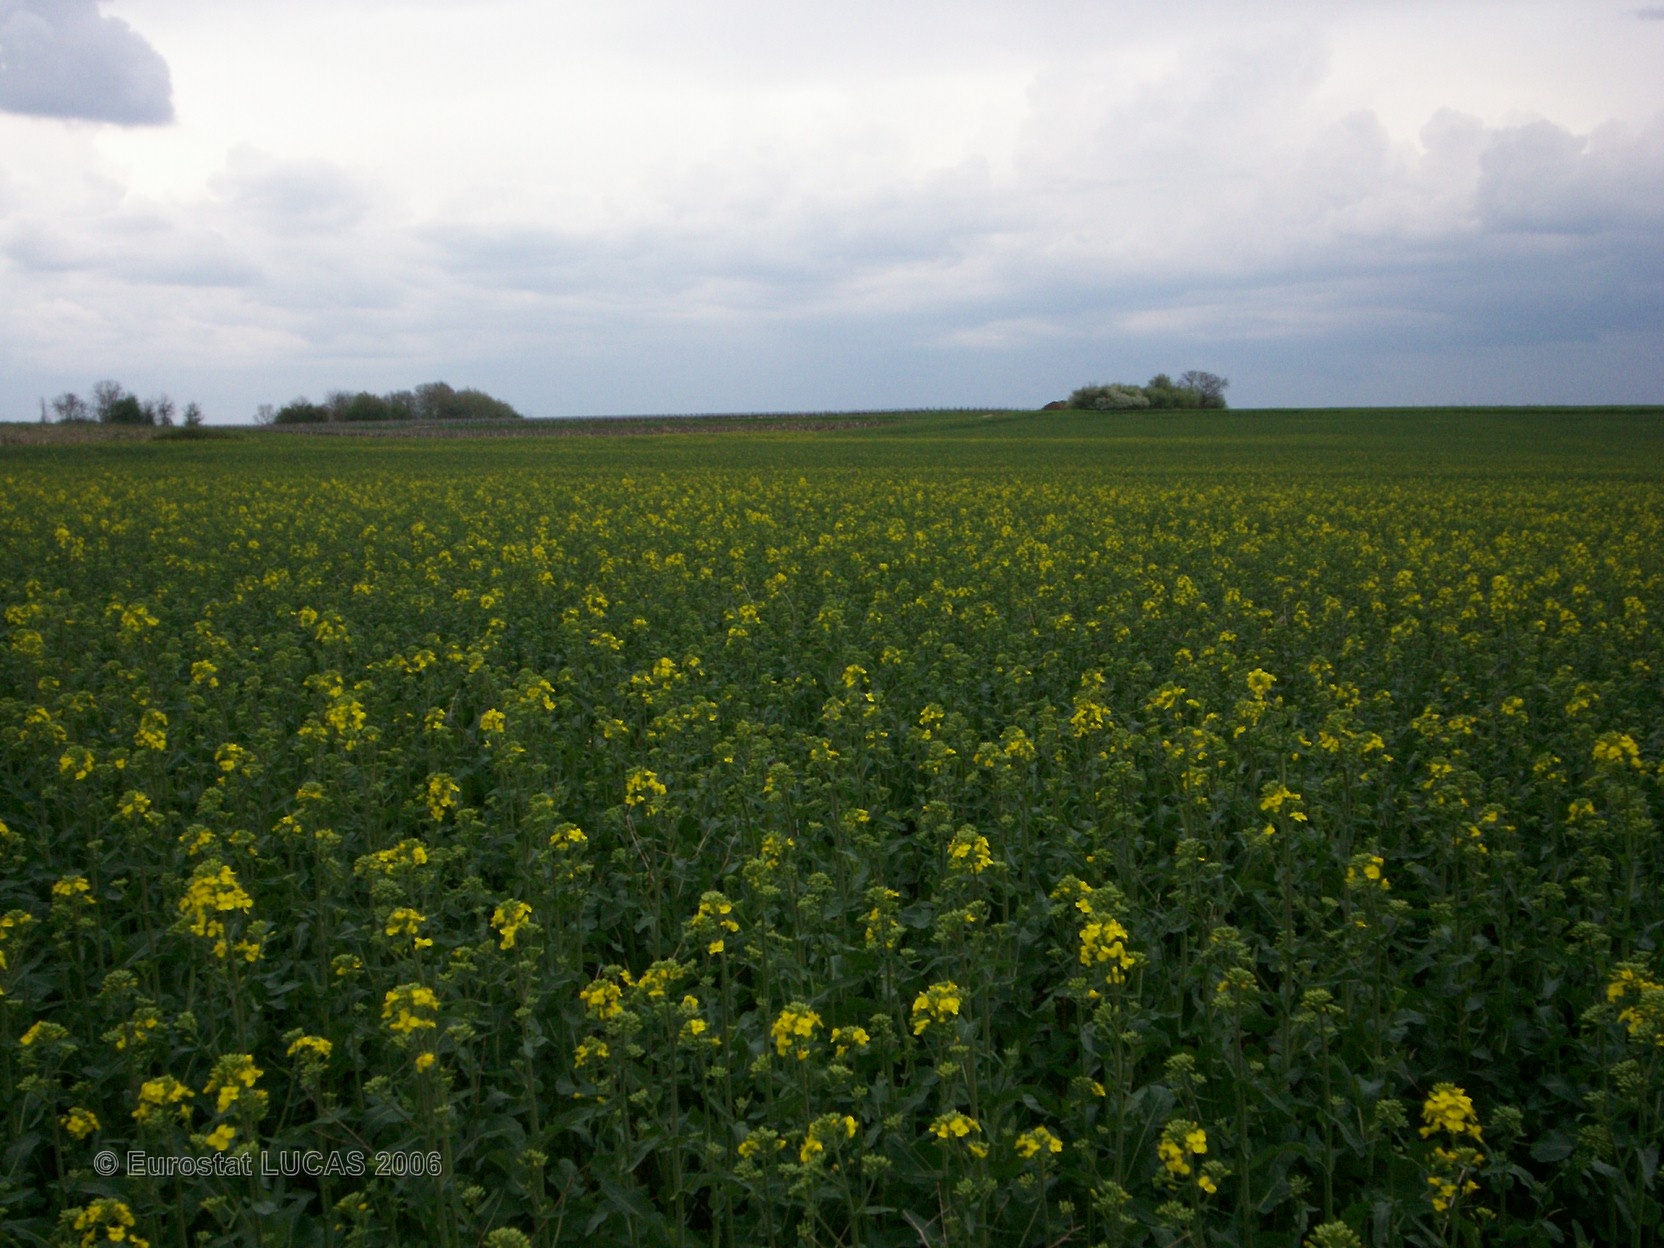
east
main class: Cropland
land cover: Rape and turnip rape
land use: Agriculture (excluding fallow land and kitchen gardens)
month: April
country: FR
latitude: 47.2947
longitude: 2.9728
